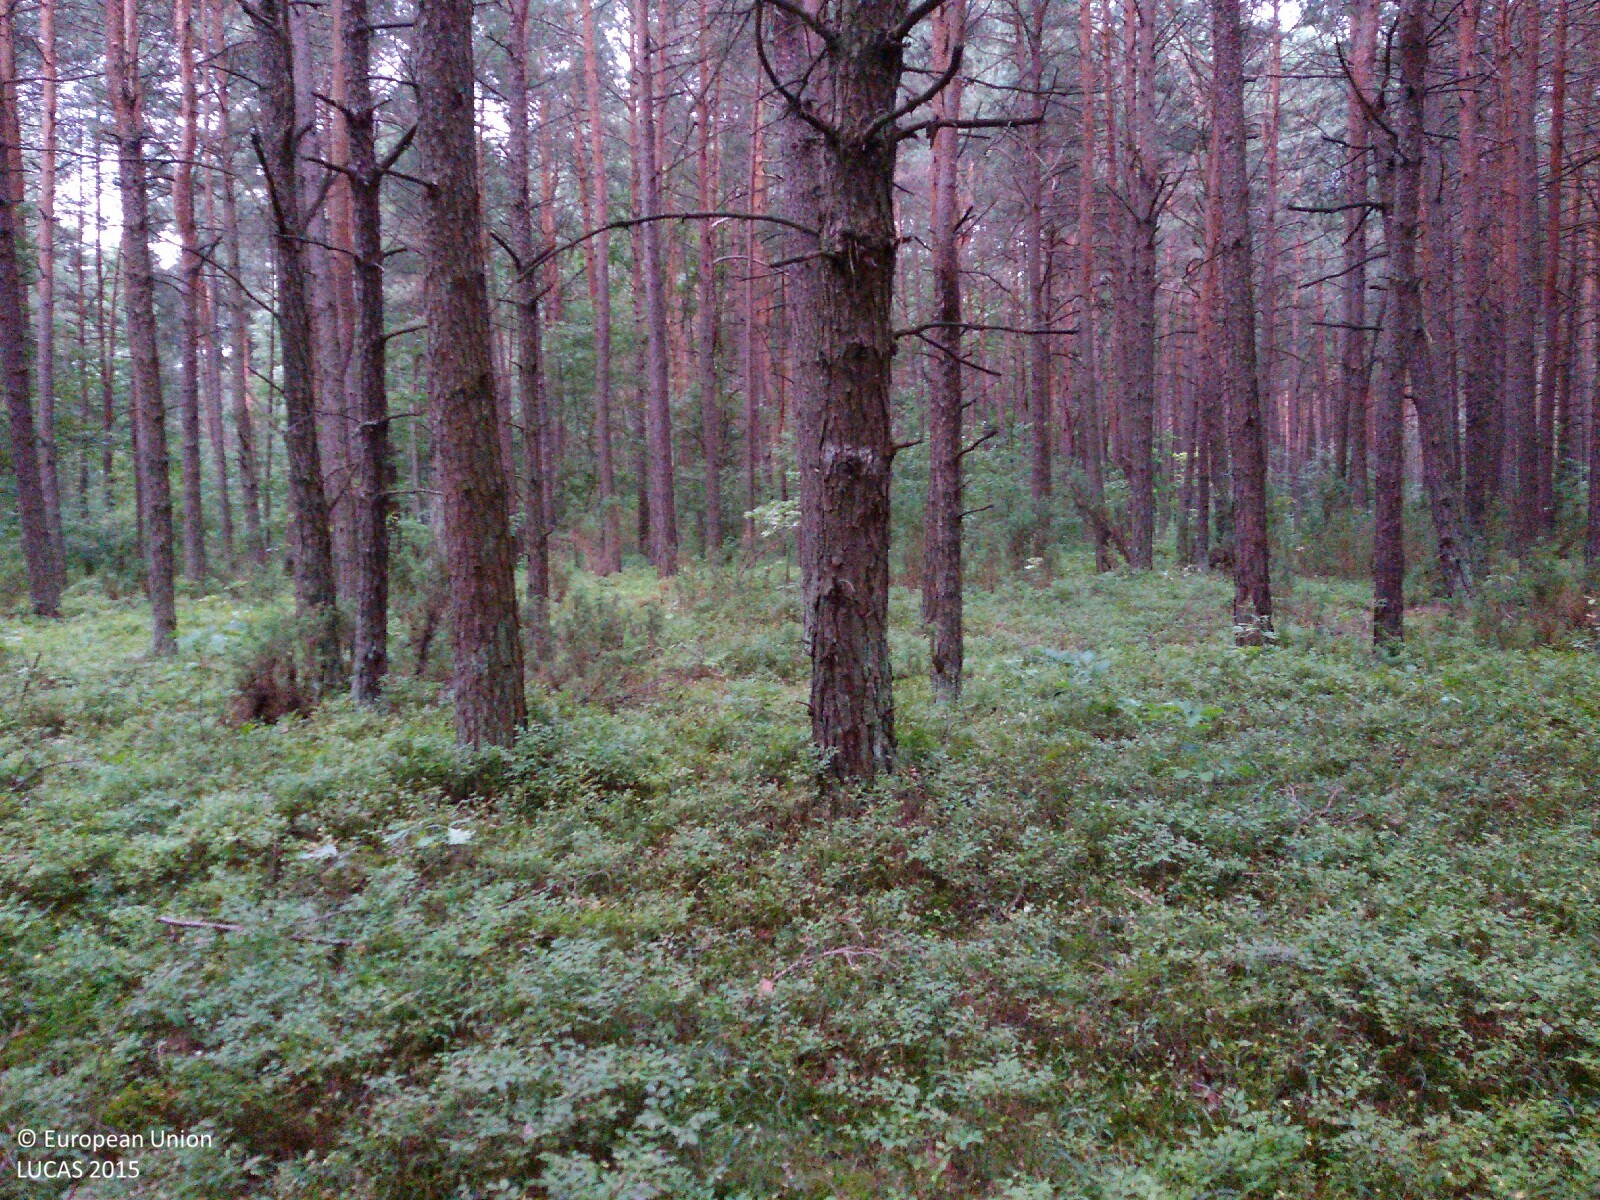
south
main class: Woodland
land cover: Pine dominated coniferous woodland
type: hemiboreal forest and nemoral coniferous forest and mixed broadleaved-coniferous forest
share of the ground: > 75 %
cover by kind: coniferous forest trees 85 %, herbaceous plants 10 %, shrubs 5 %
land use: Forestry
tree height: > 5 m
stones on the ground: < 10 %
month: July
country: PL
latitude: 51.8853
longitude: 21.7208
